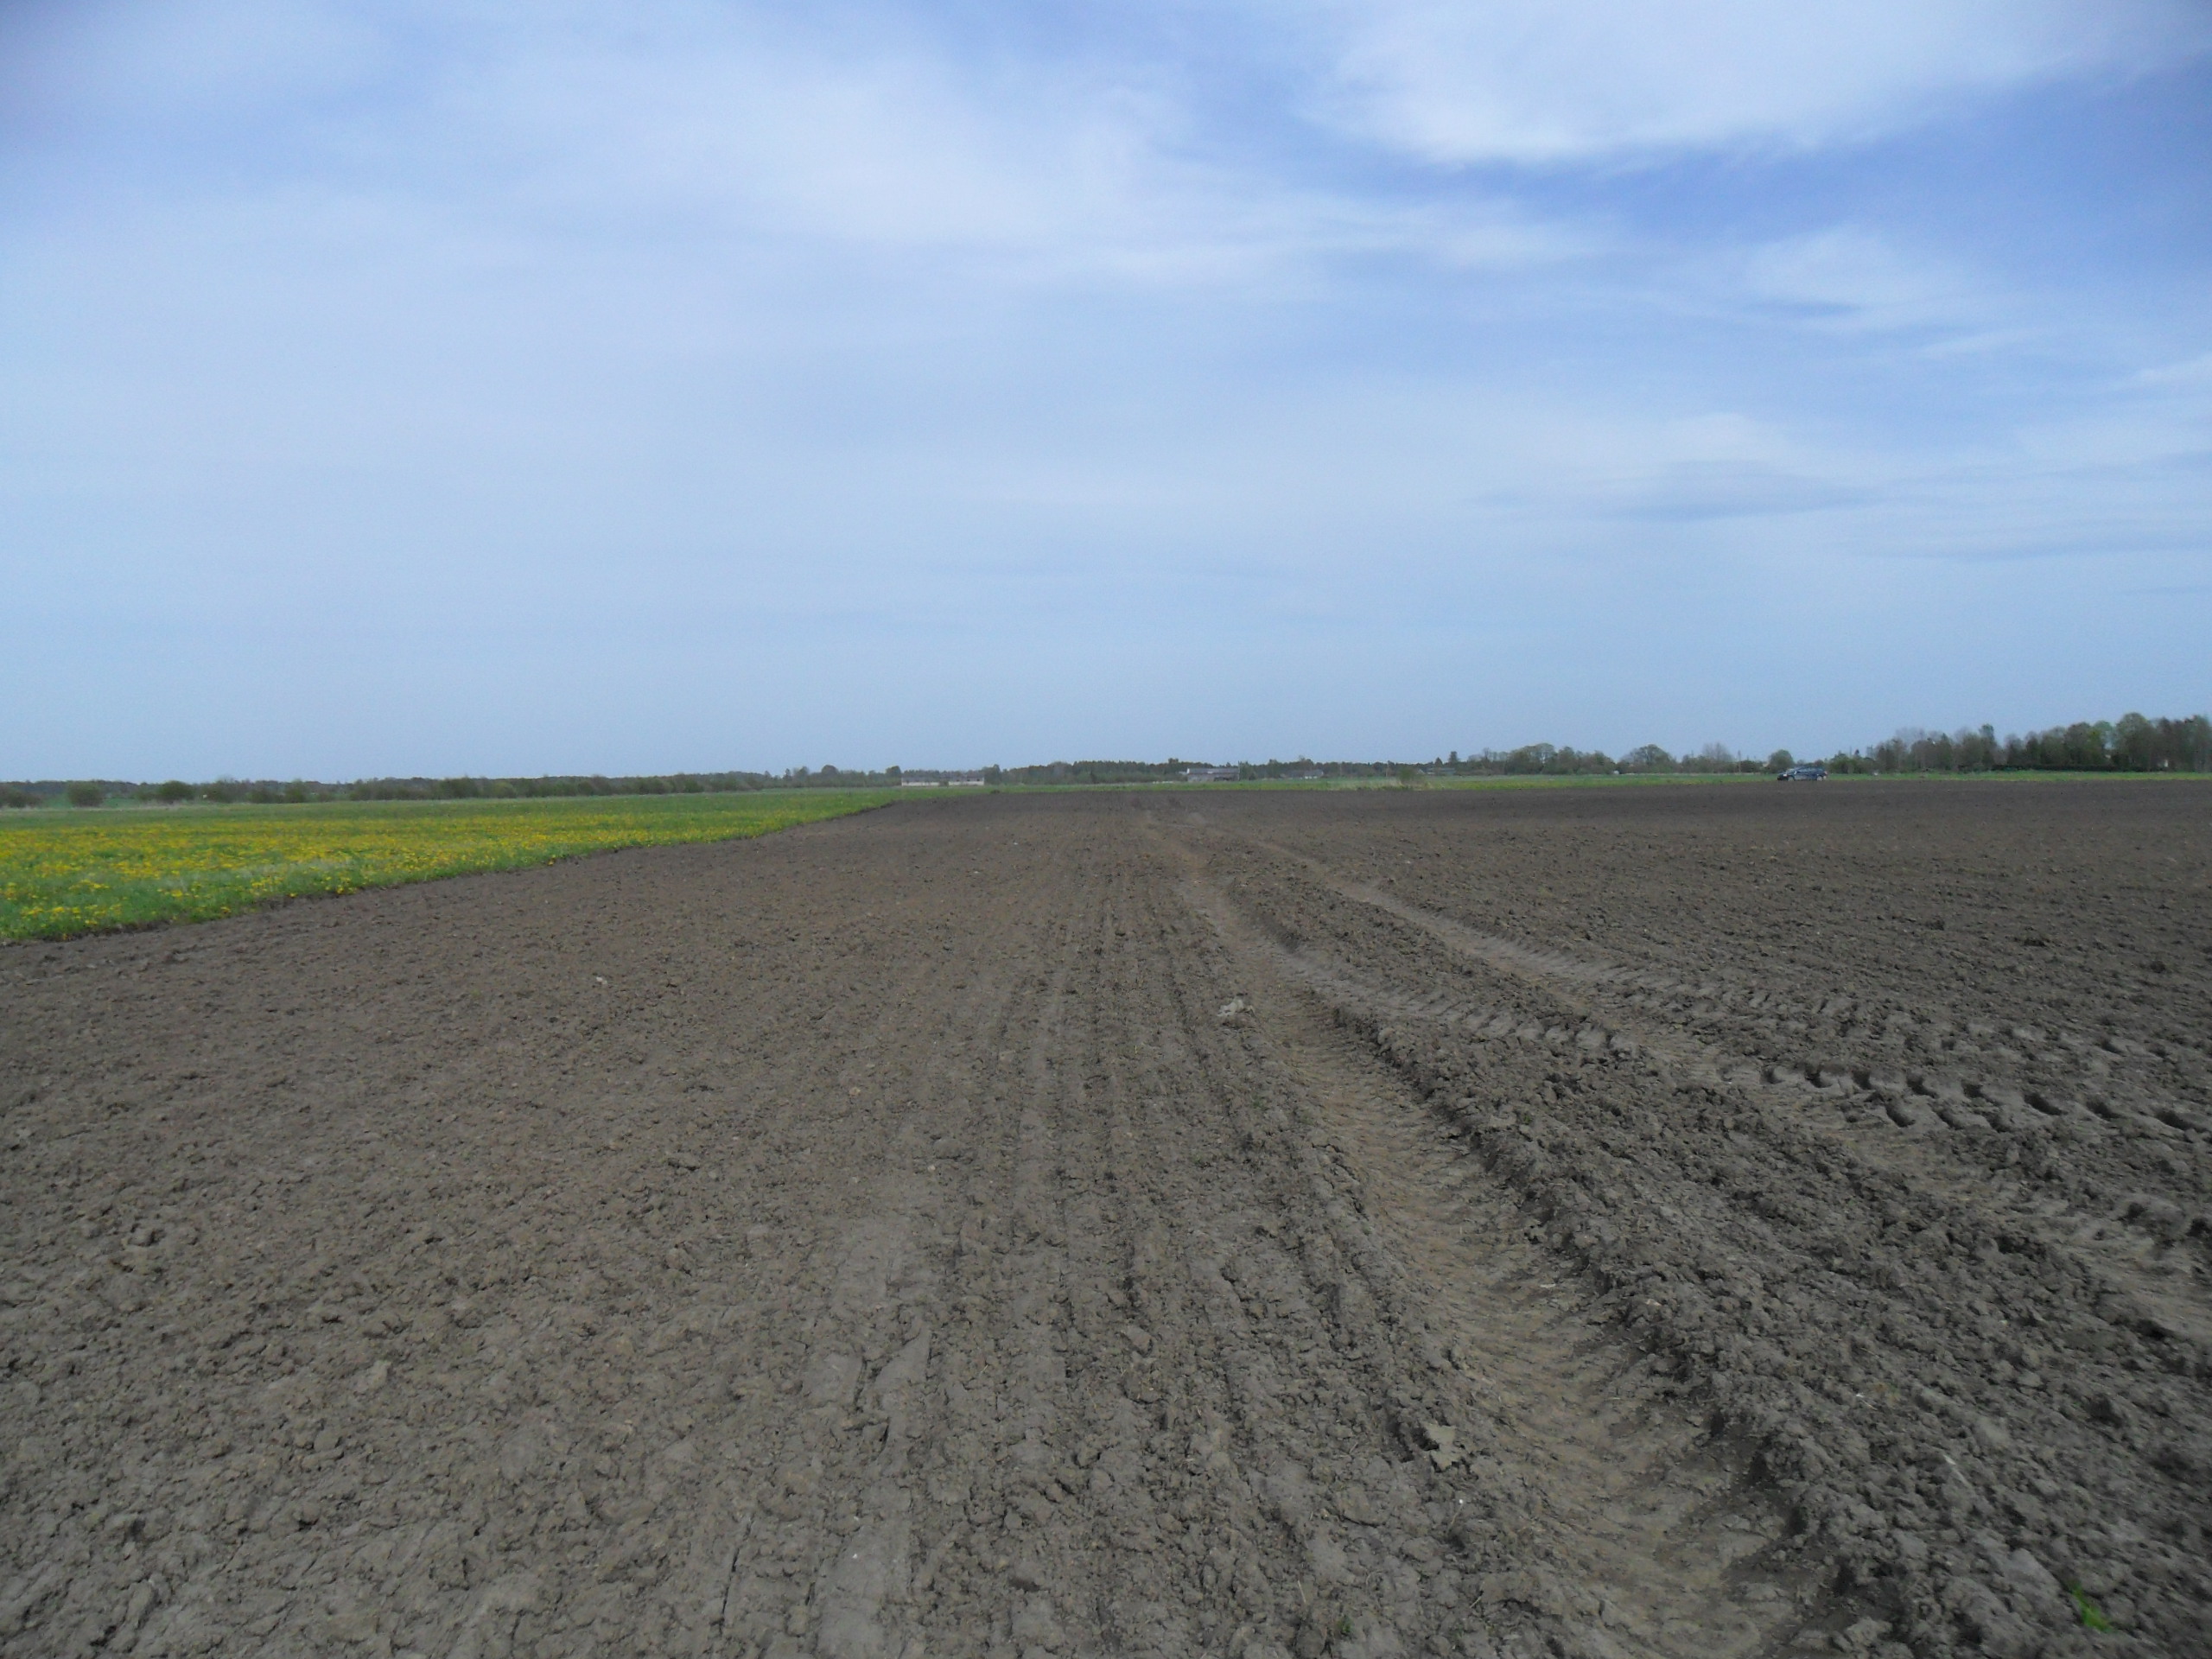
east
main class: Cropland
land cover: Rape and turnip rape
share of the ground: < 10 %
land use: Agriculture (excluding fallow land and kitchen gardens)
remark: Tilled/Sowed
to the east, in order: Rape and turnip rape; Single bushes/trees; Grassland without tree/shrub cover
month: May
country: LV
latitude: 57.2728
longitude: 23.0149
